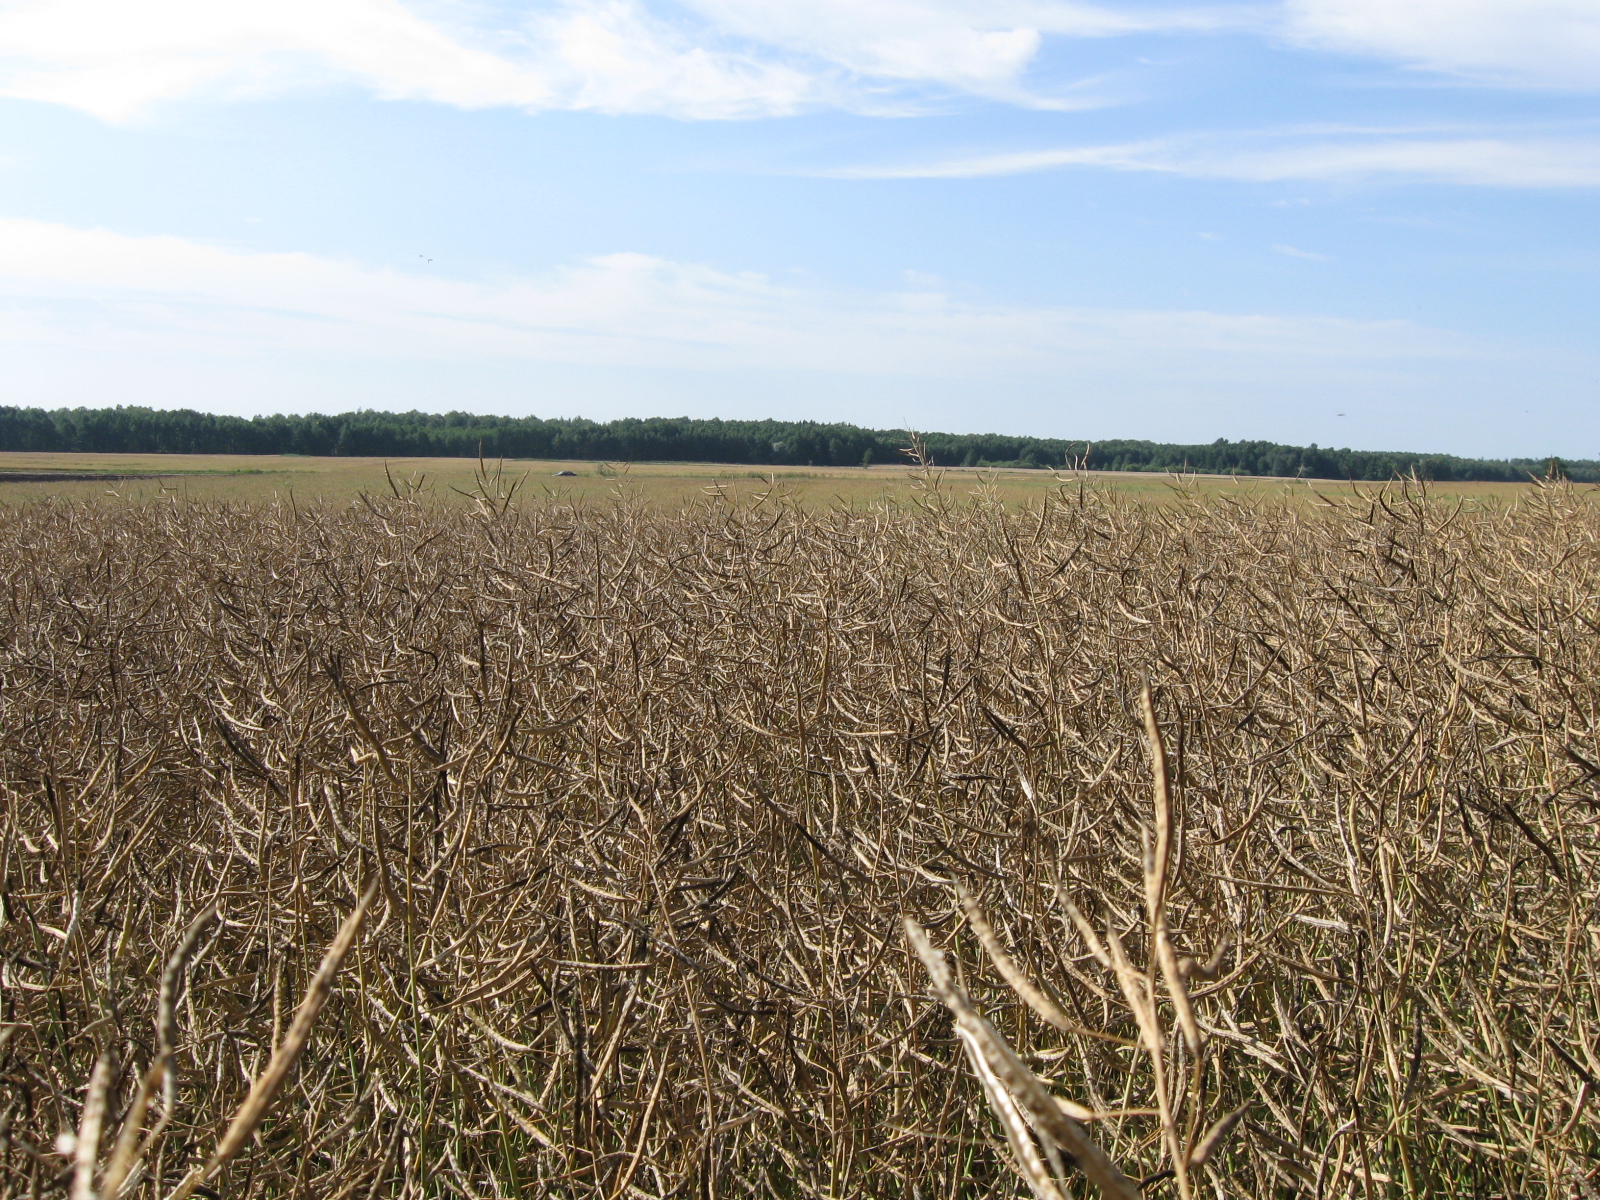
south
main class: Cropland
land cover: Rape and turnip rape
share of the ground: > 75 %
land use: Agriculture (excluding fallow land and kitchen gardens)
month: July
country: LT
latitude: 54.4922
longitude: 23.5924
